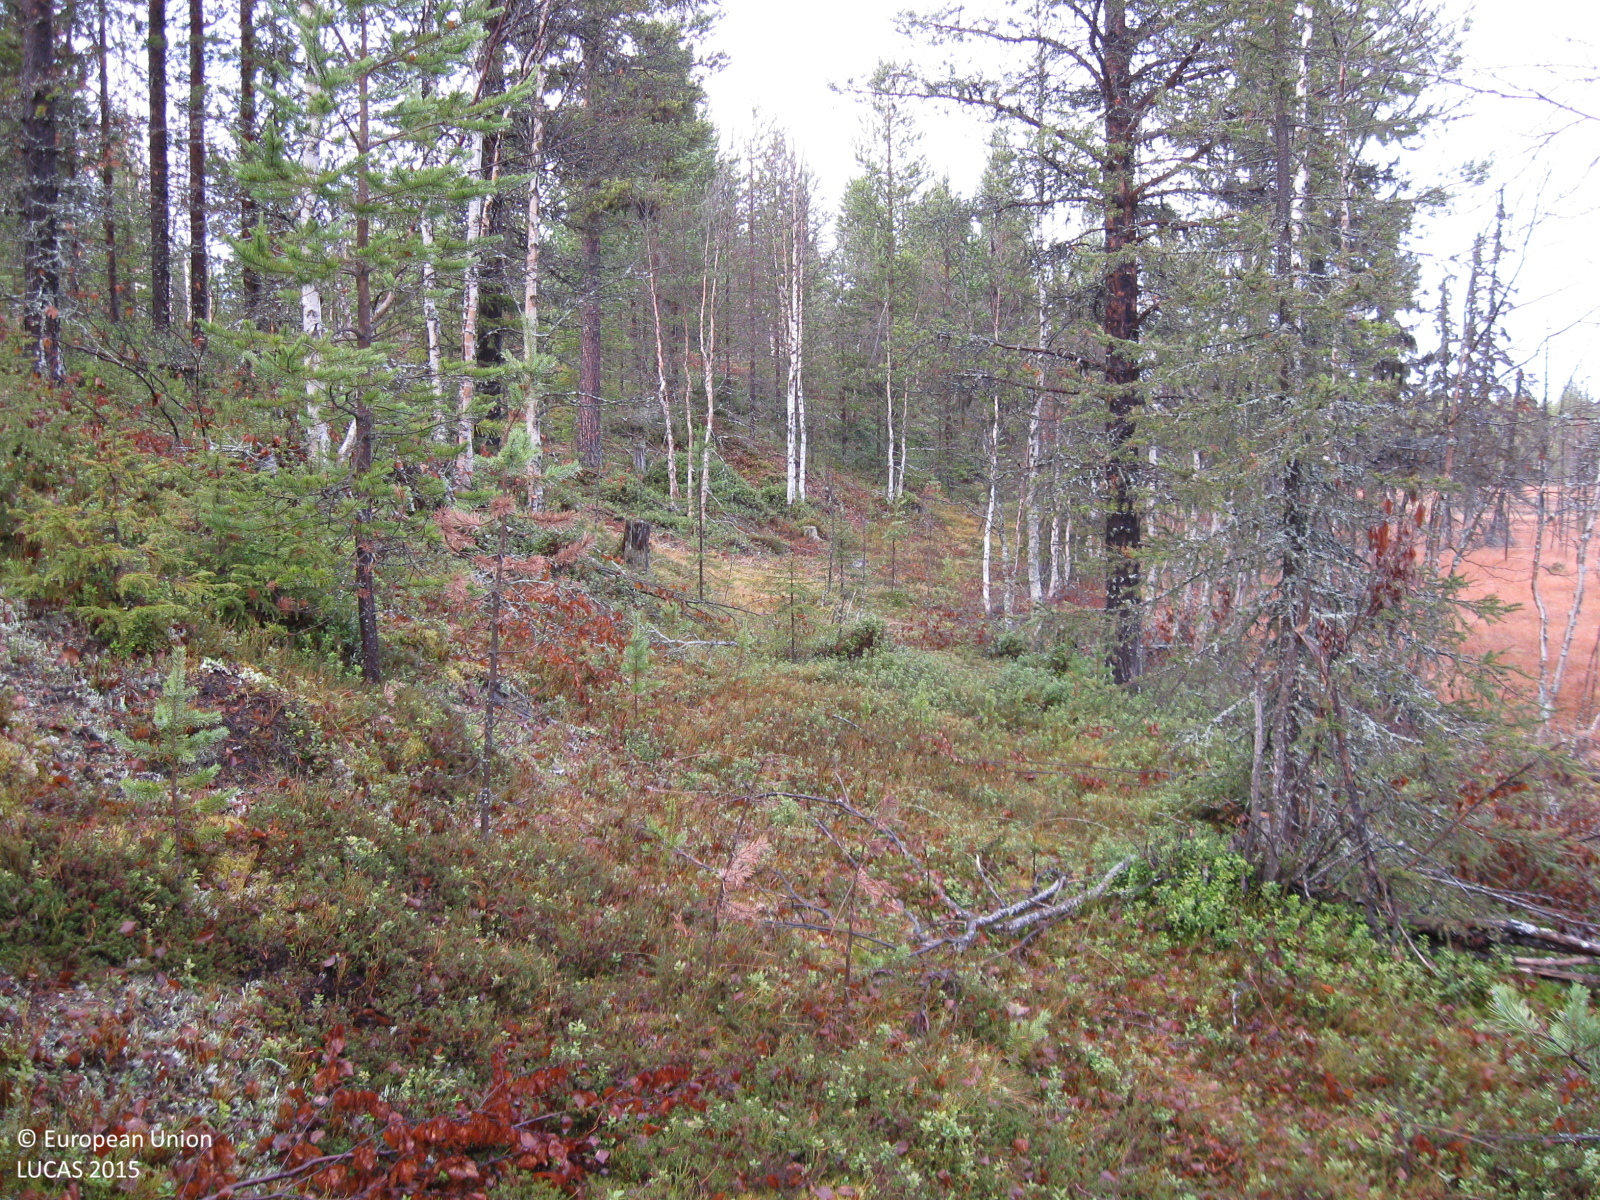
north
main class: Woodland
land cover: Pine dominated mixed woodland
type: boreal forest
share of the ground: 25 - 50 %
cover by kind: herbaceous plants 25 %, coniferous forest trees 20 %, broadleaved forest trees 20 %, shrubs 20 %, lichens and mosses 15 %
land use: Forestry
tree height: > 5 m
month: October
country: SE
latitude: 66.8289
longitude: 21.0466
